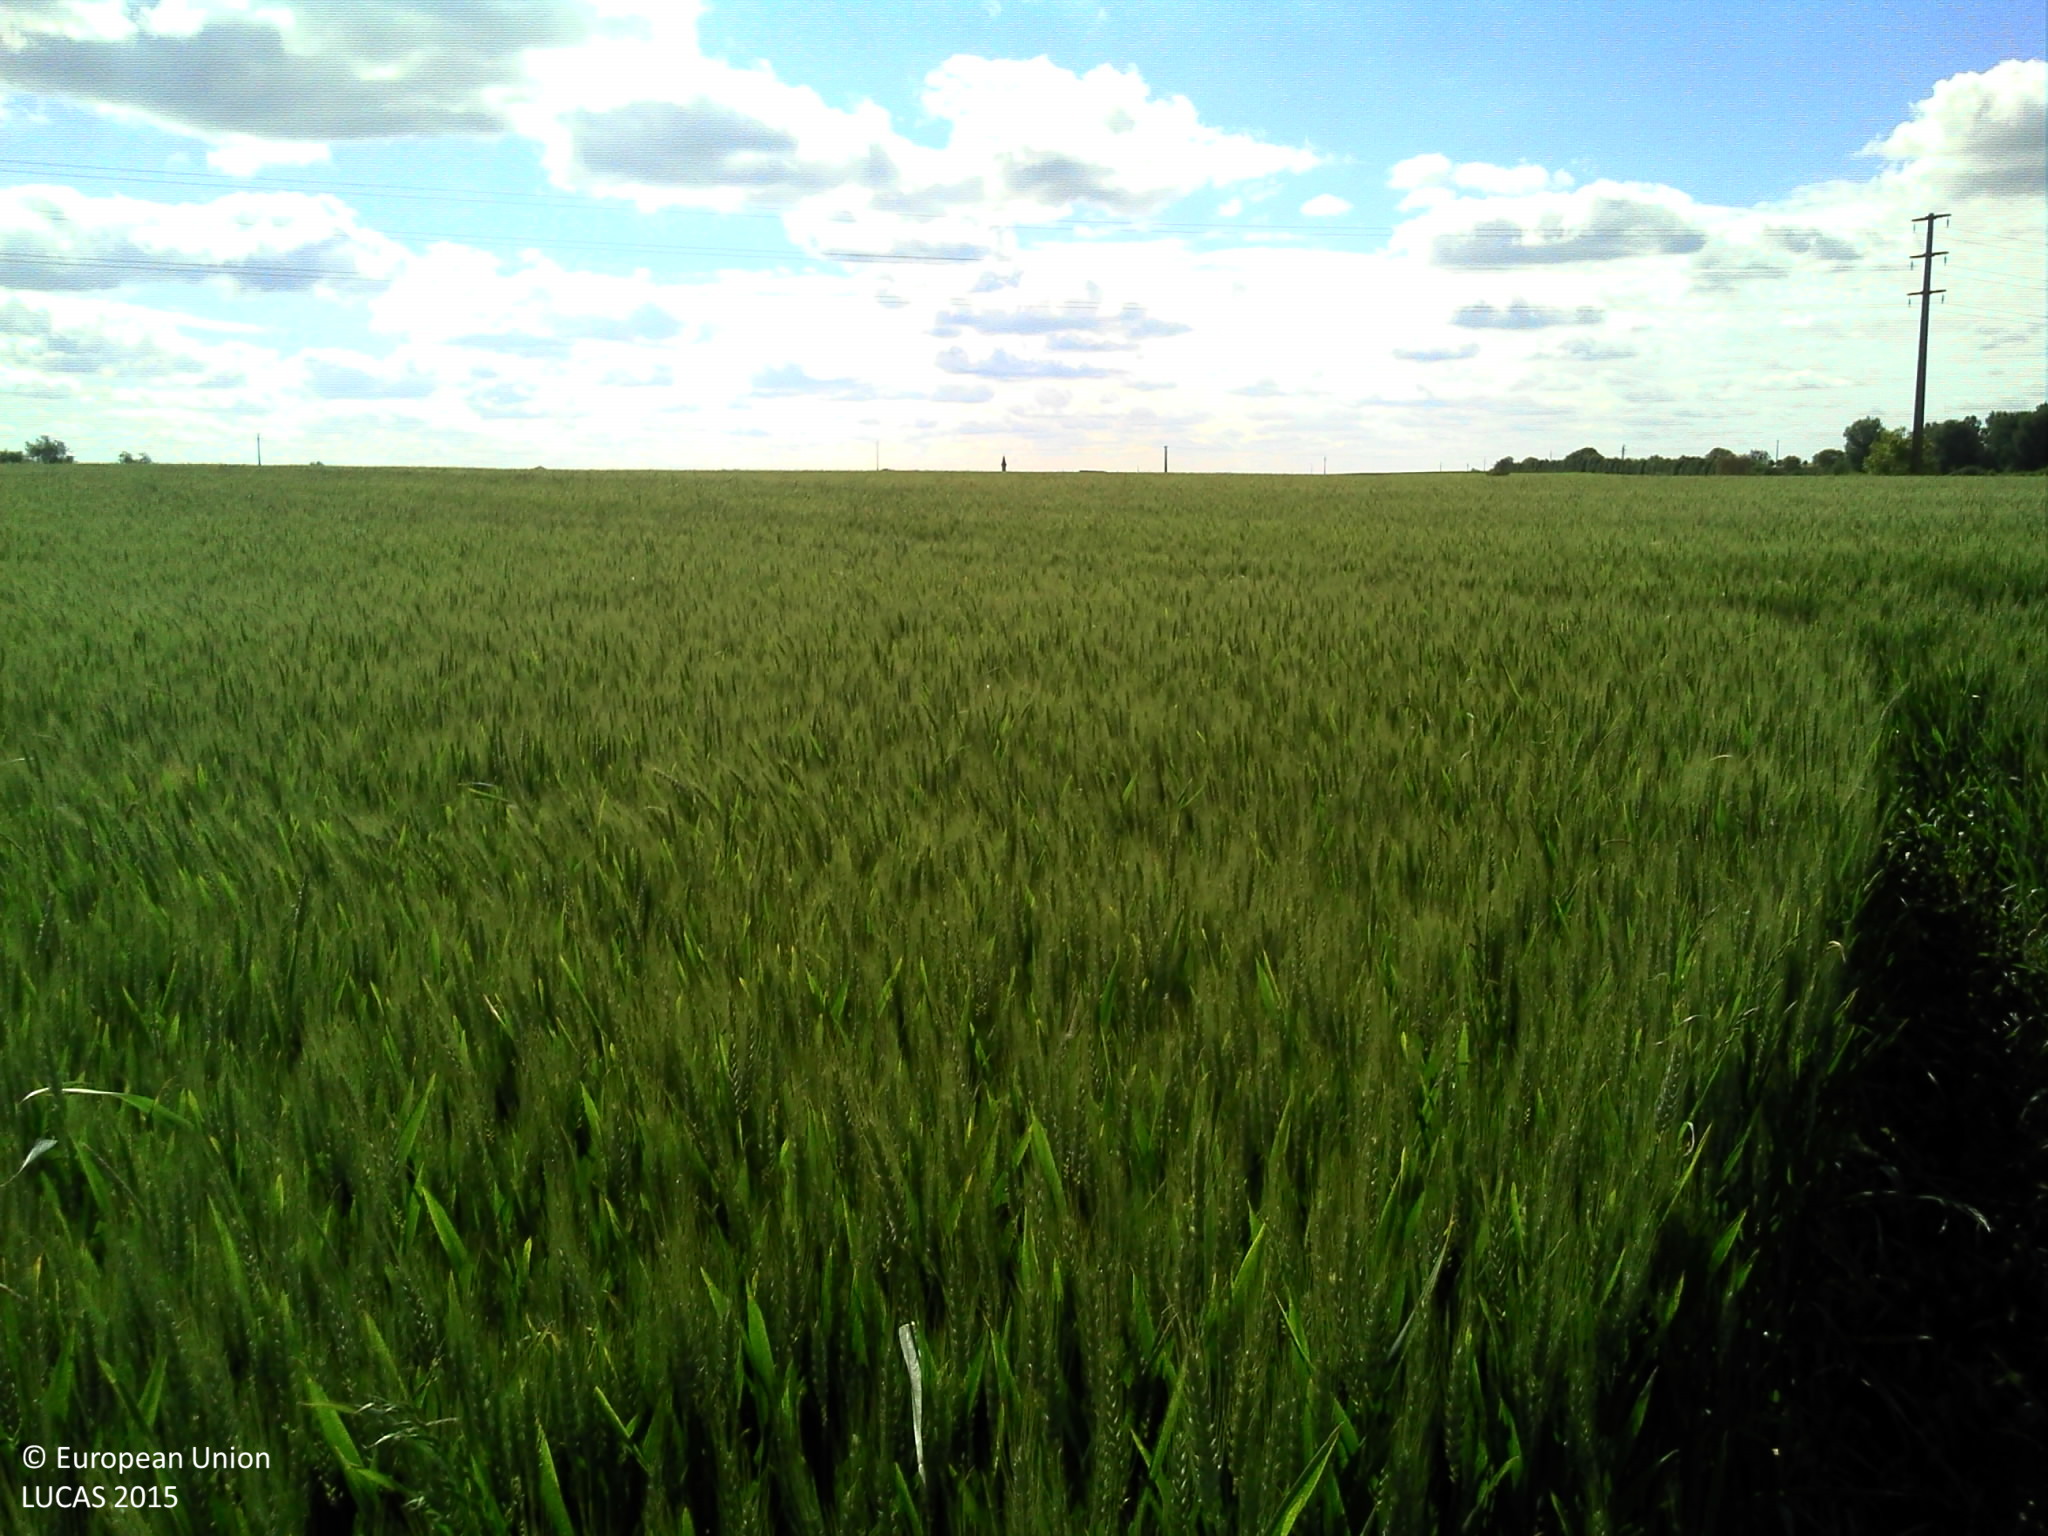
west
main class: Cropland
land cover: Common wheat
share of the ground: > 75 %
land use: Agriculture (excluding fallow land and kitchen gardens)
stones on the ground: < 10 %
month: May
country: FR
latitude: 46.7704
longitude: 0.1967
